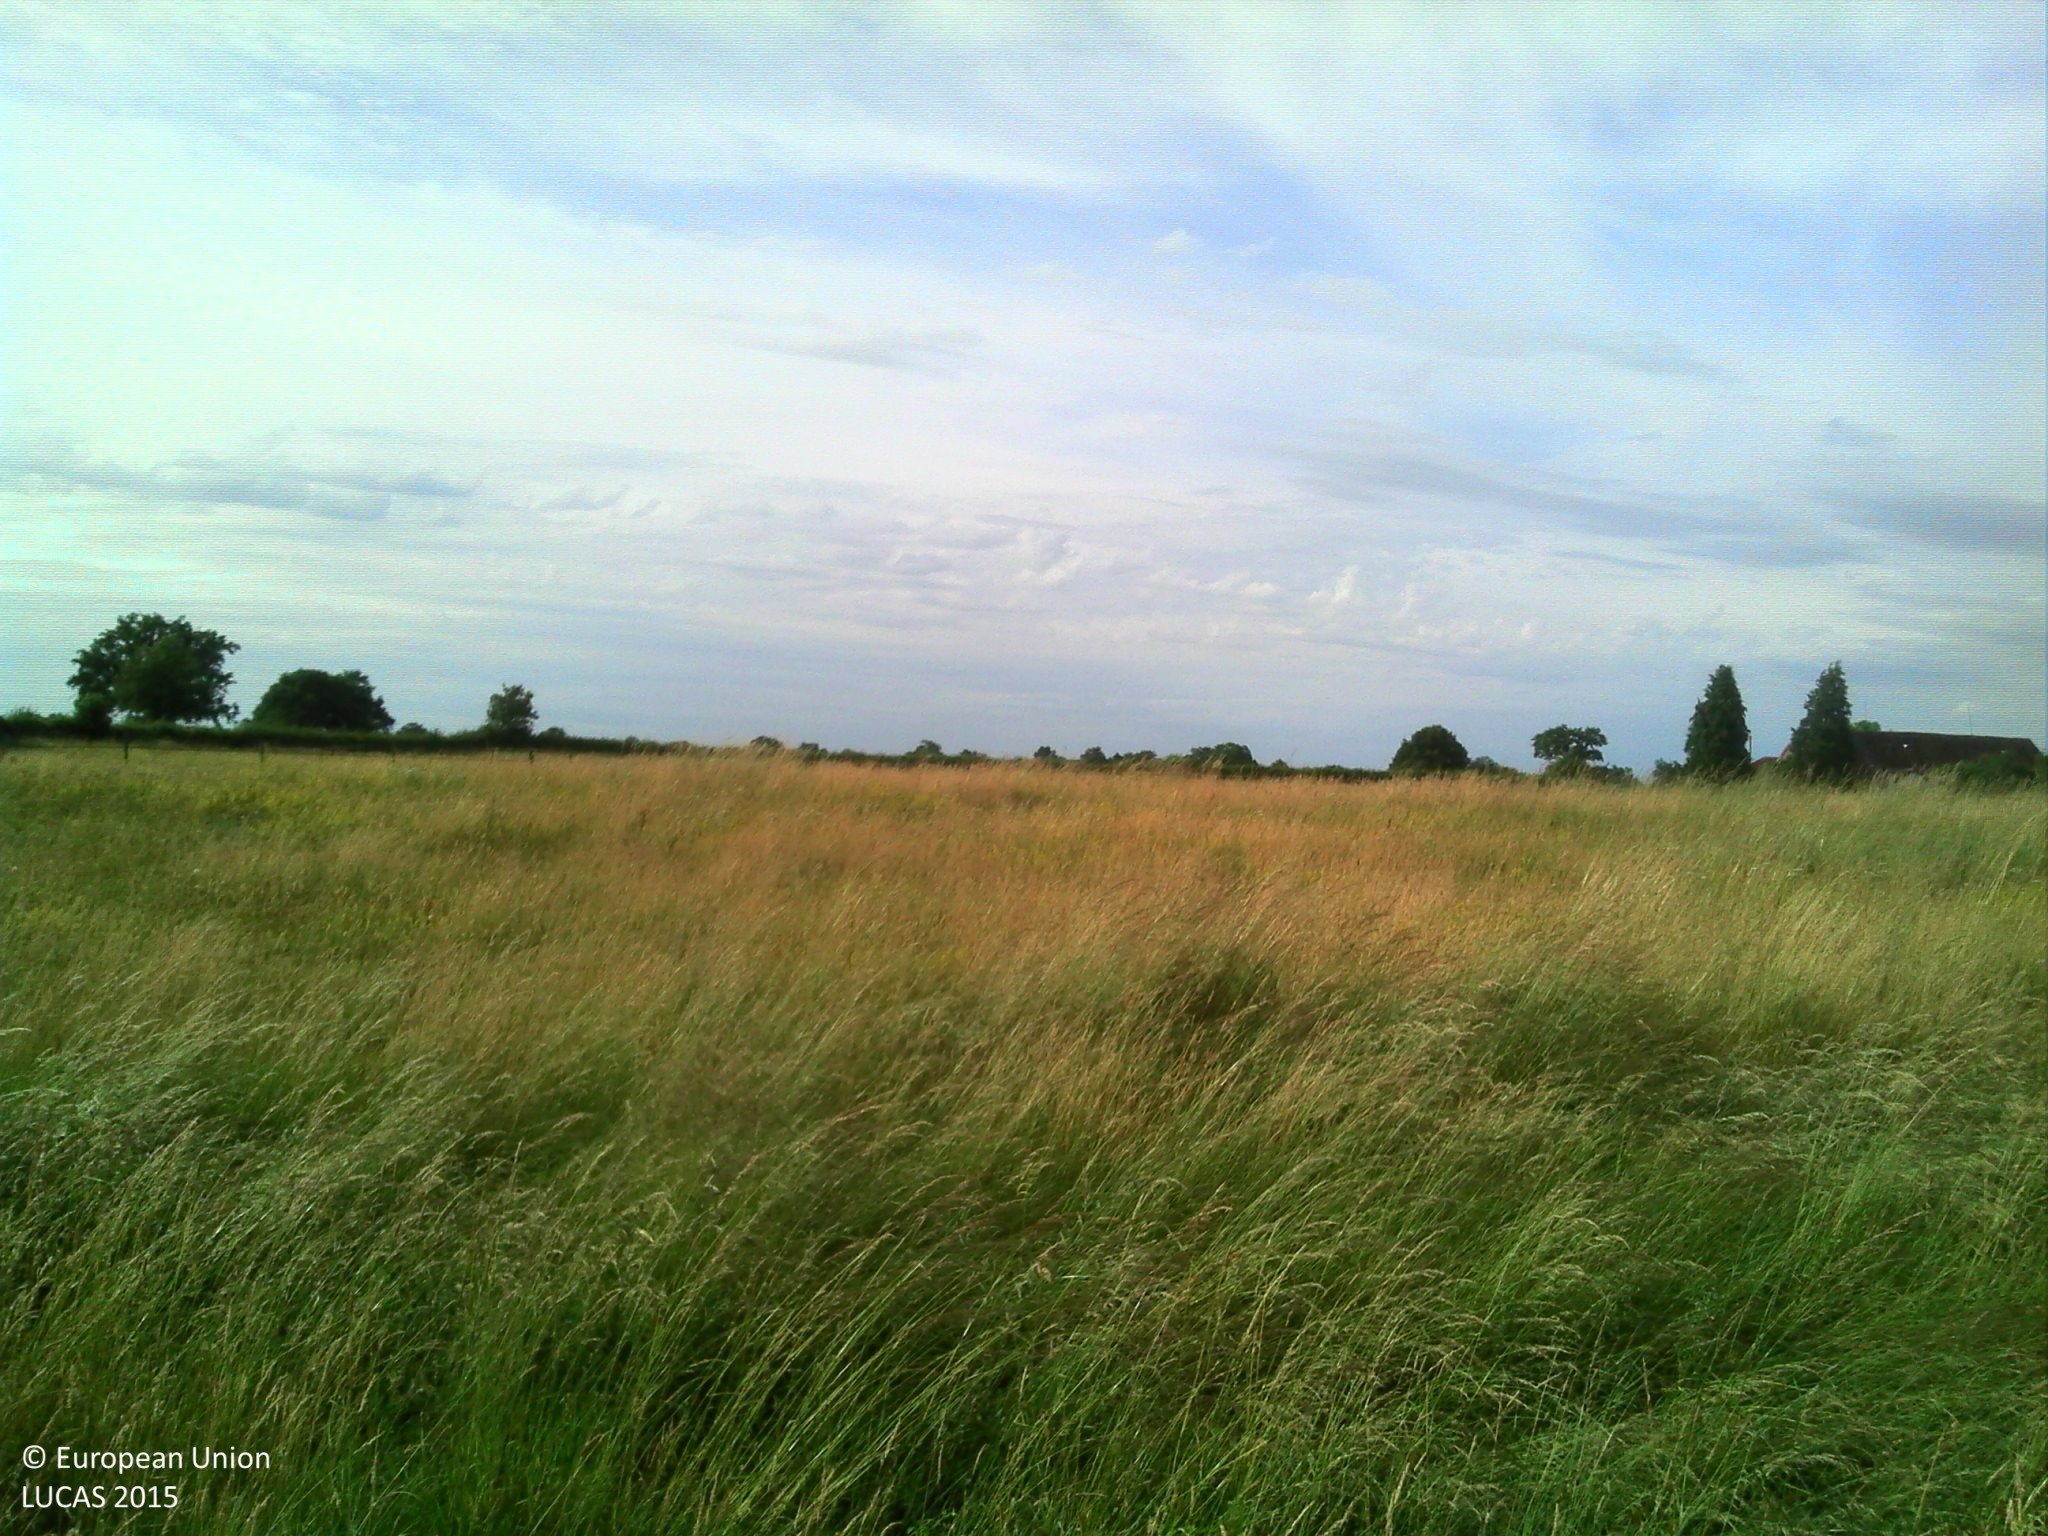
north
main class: Grassland
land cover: Grassland without tree/shrub cover
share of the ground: > 75 %
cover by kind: herbaceous plants 100 %
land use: Agriculture (excluding fallow land and kitchen gardens)
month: June
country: FR
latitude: 46.4385
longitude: 4.0524
